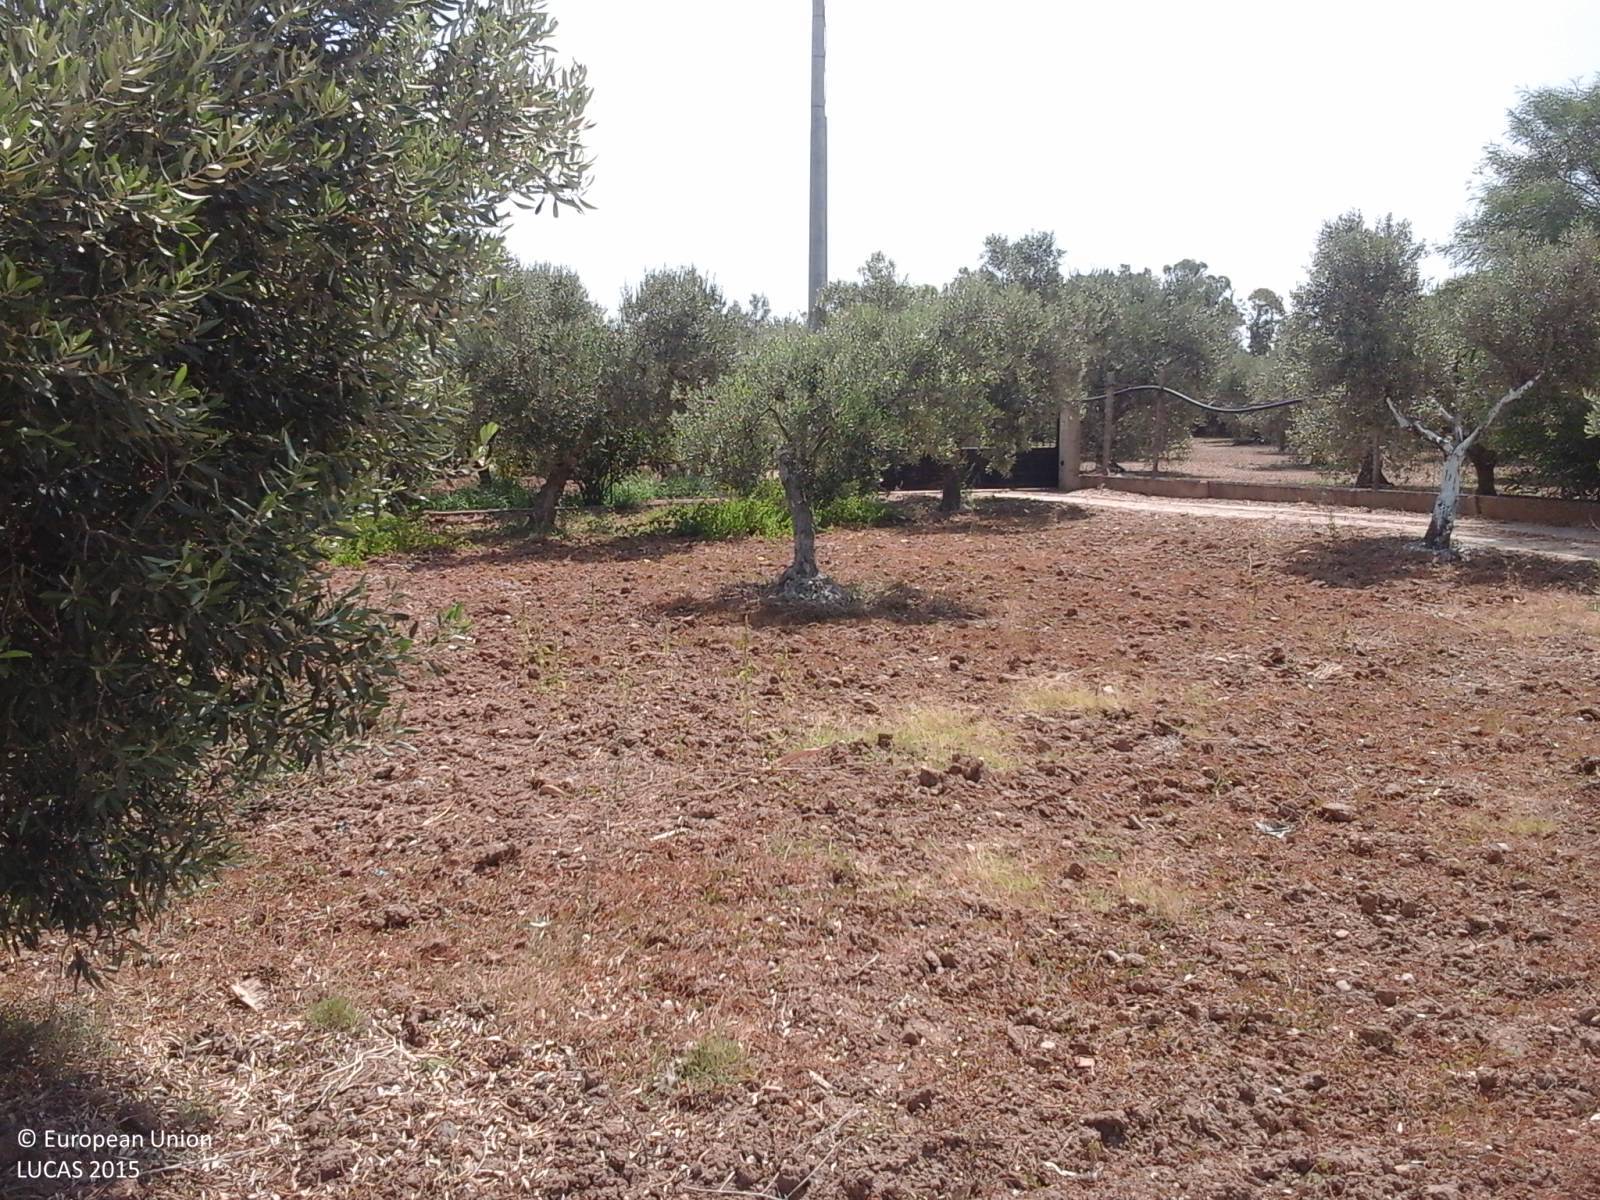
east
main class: Cropland
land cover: Olive groves
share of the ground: > 75 %
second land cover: Grassland without tree/shrub cover
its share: > 75 %
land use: Agriculture (excluding fallow land and kitchen gardens)
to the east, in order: Olive groves; Grassland without tree/shrub cover; Fences; Lines of trees; Other fruit trees and berries; Artificial constructions in urban areas; Grassland without tree/shrub cover; Olive groves; Arable land (only in case pi); Lines of trees; Grass margins; Paved roads, cycling and walking lanes; Olive groves; Tracks; Grass margins; Grassland without tree/shrub cover
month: July
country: IT
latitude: 39.5005
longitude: 8.9018
